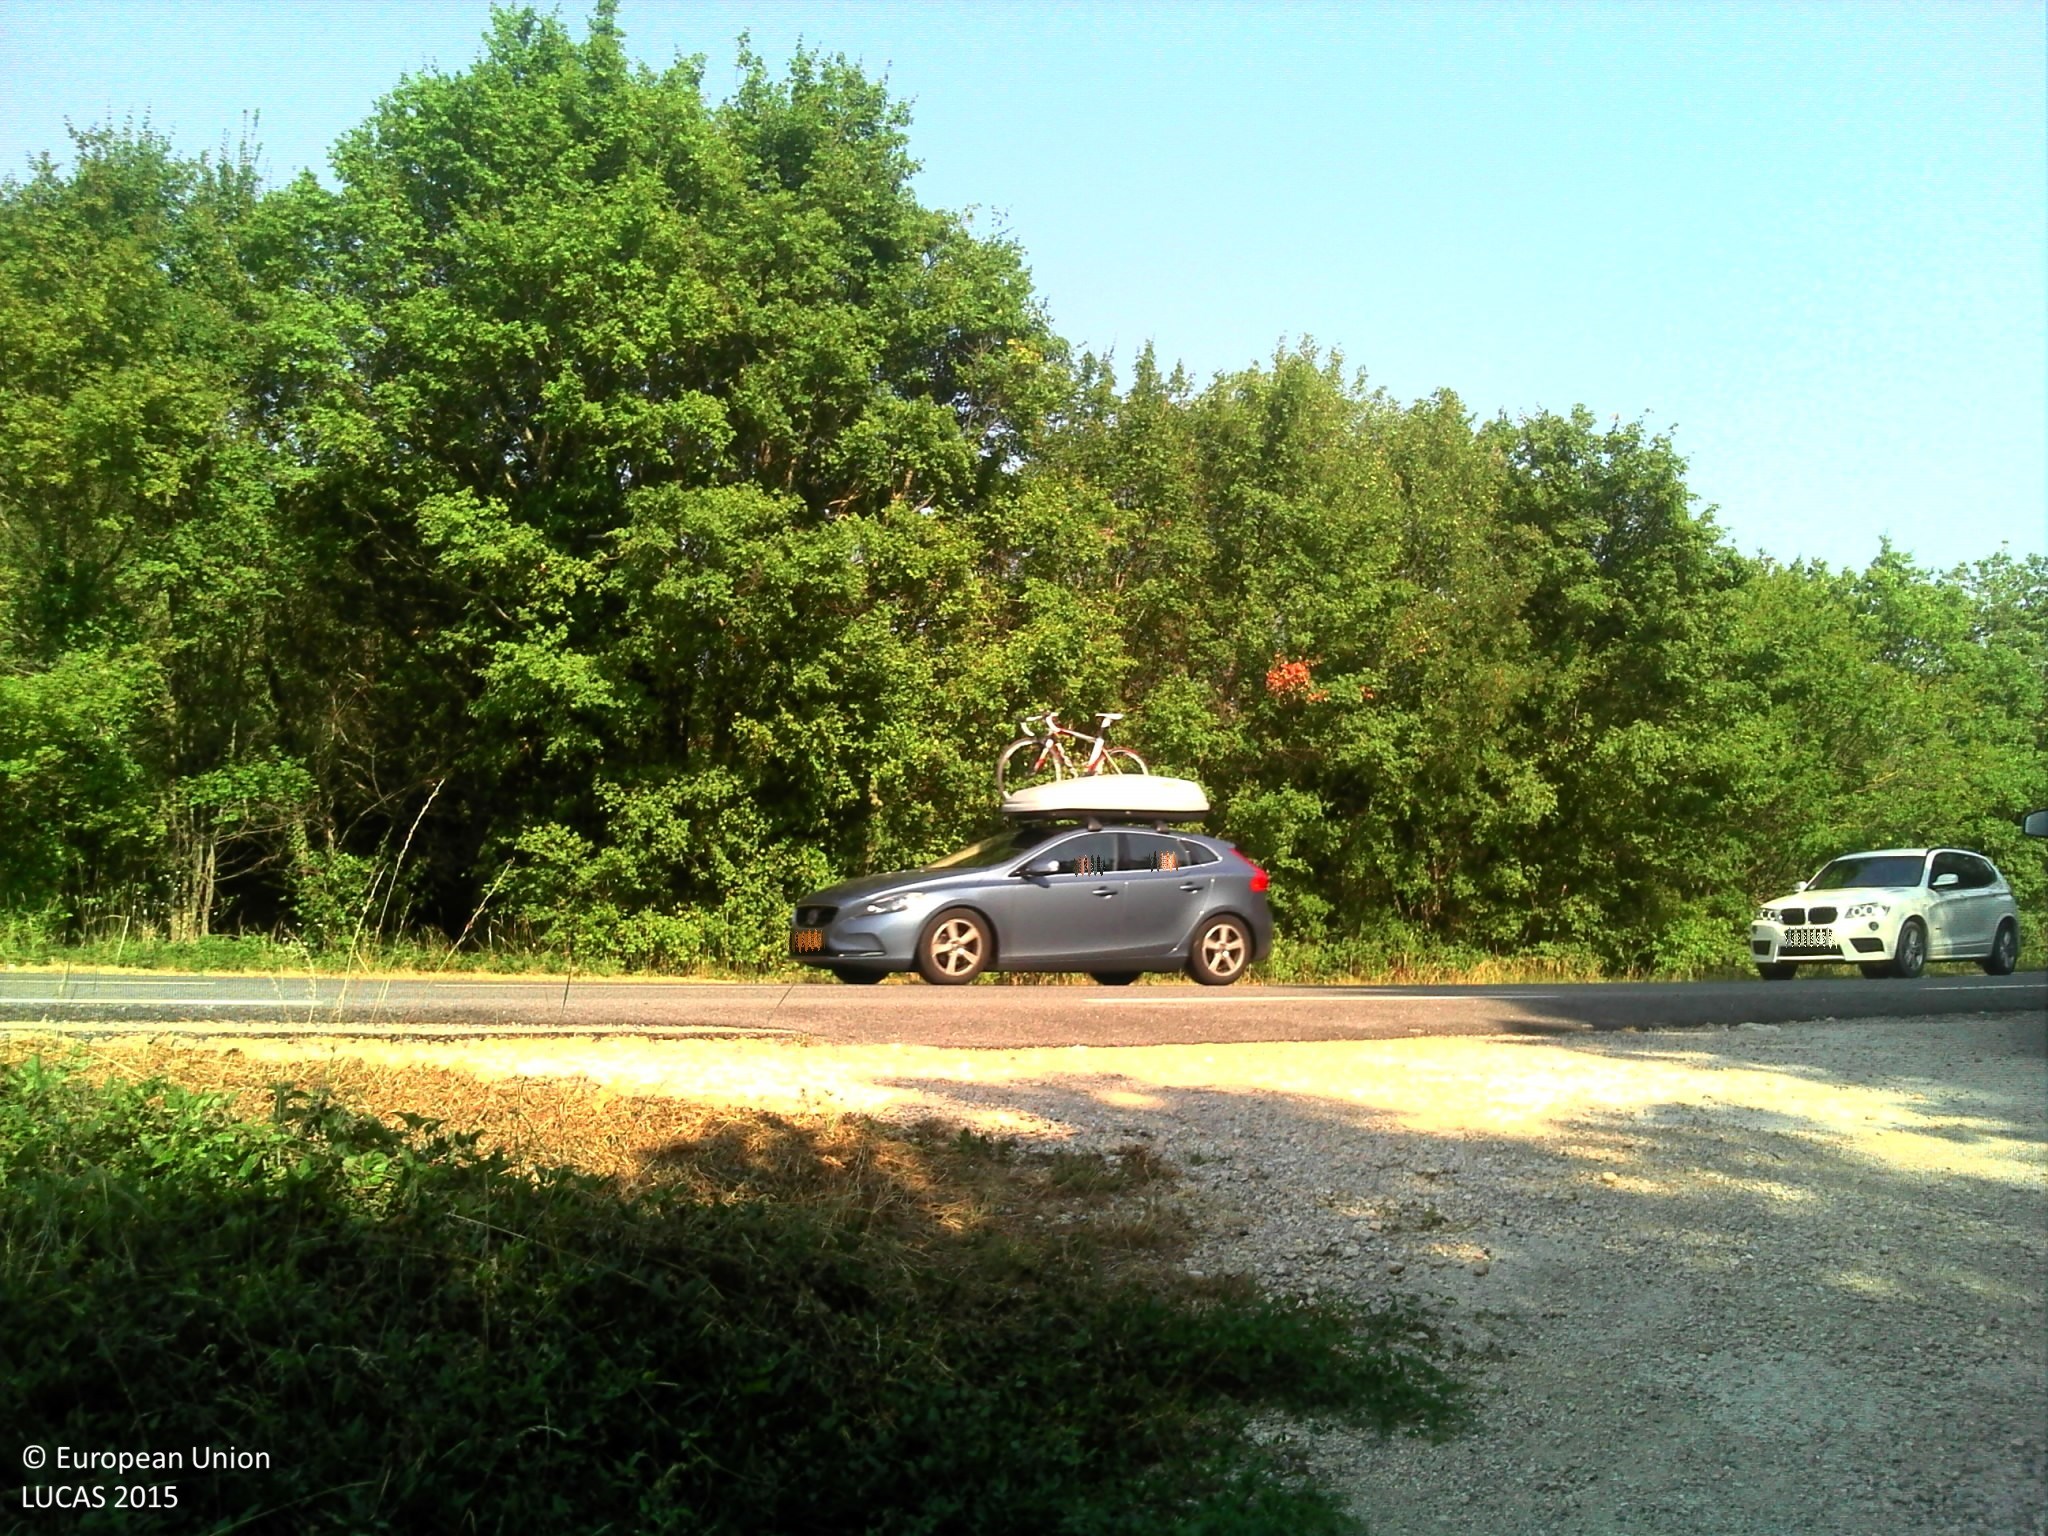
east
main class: Shrubland
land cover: Shrubland with sparse tree cover
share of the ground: > 75 %
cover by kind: shrubs 85 %, unconsolidated bare surface 10 %, broadleaved forest trees 5 %
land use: Community services
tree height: < 5 m
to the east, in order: Shrubland with sparse tree cover; Shrubland without tree cover; Shrubland with sparse tree cover; Shrubland without tree cover; Broadleaved woodland
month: August
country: FR
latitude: 43.6415
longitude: 6.5000
